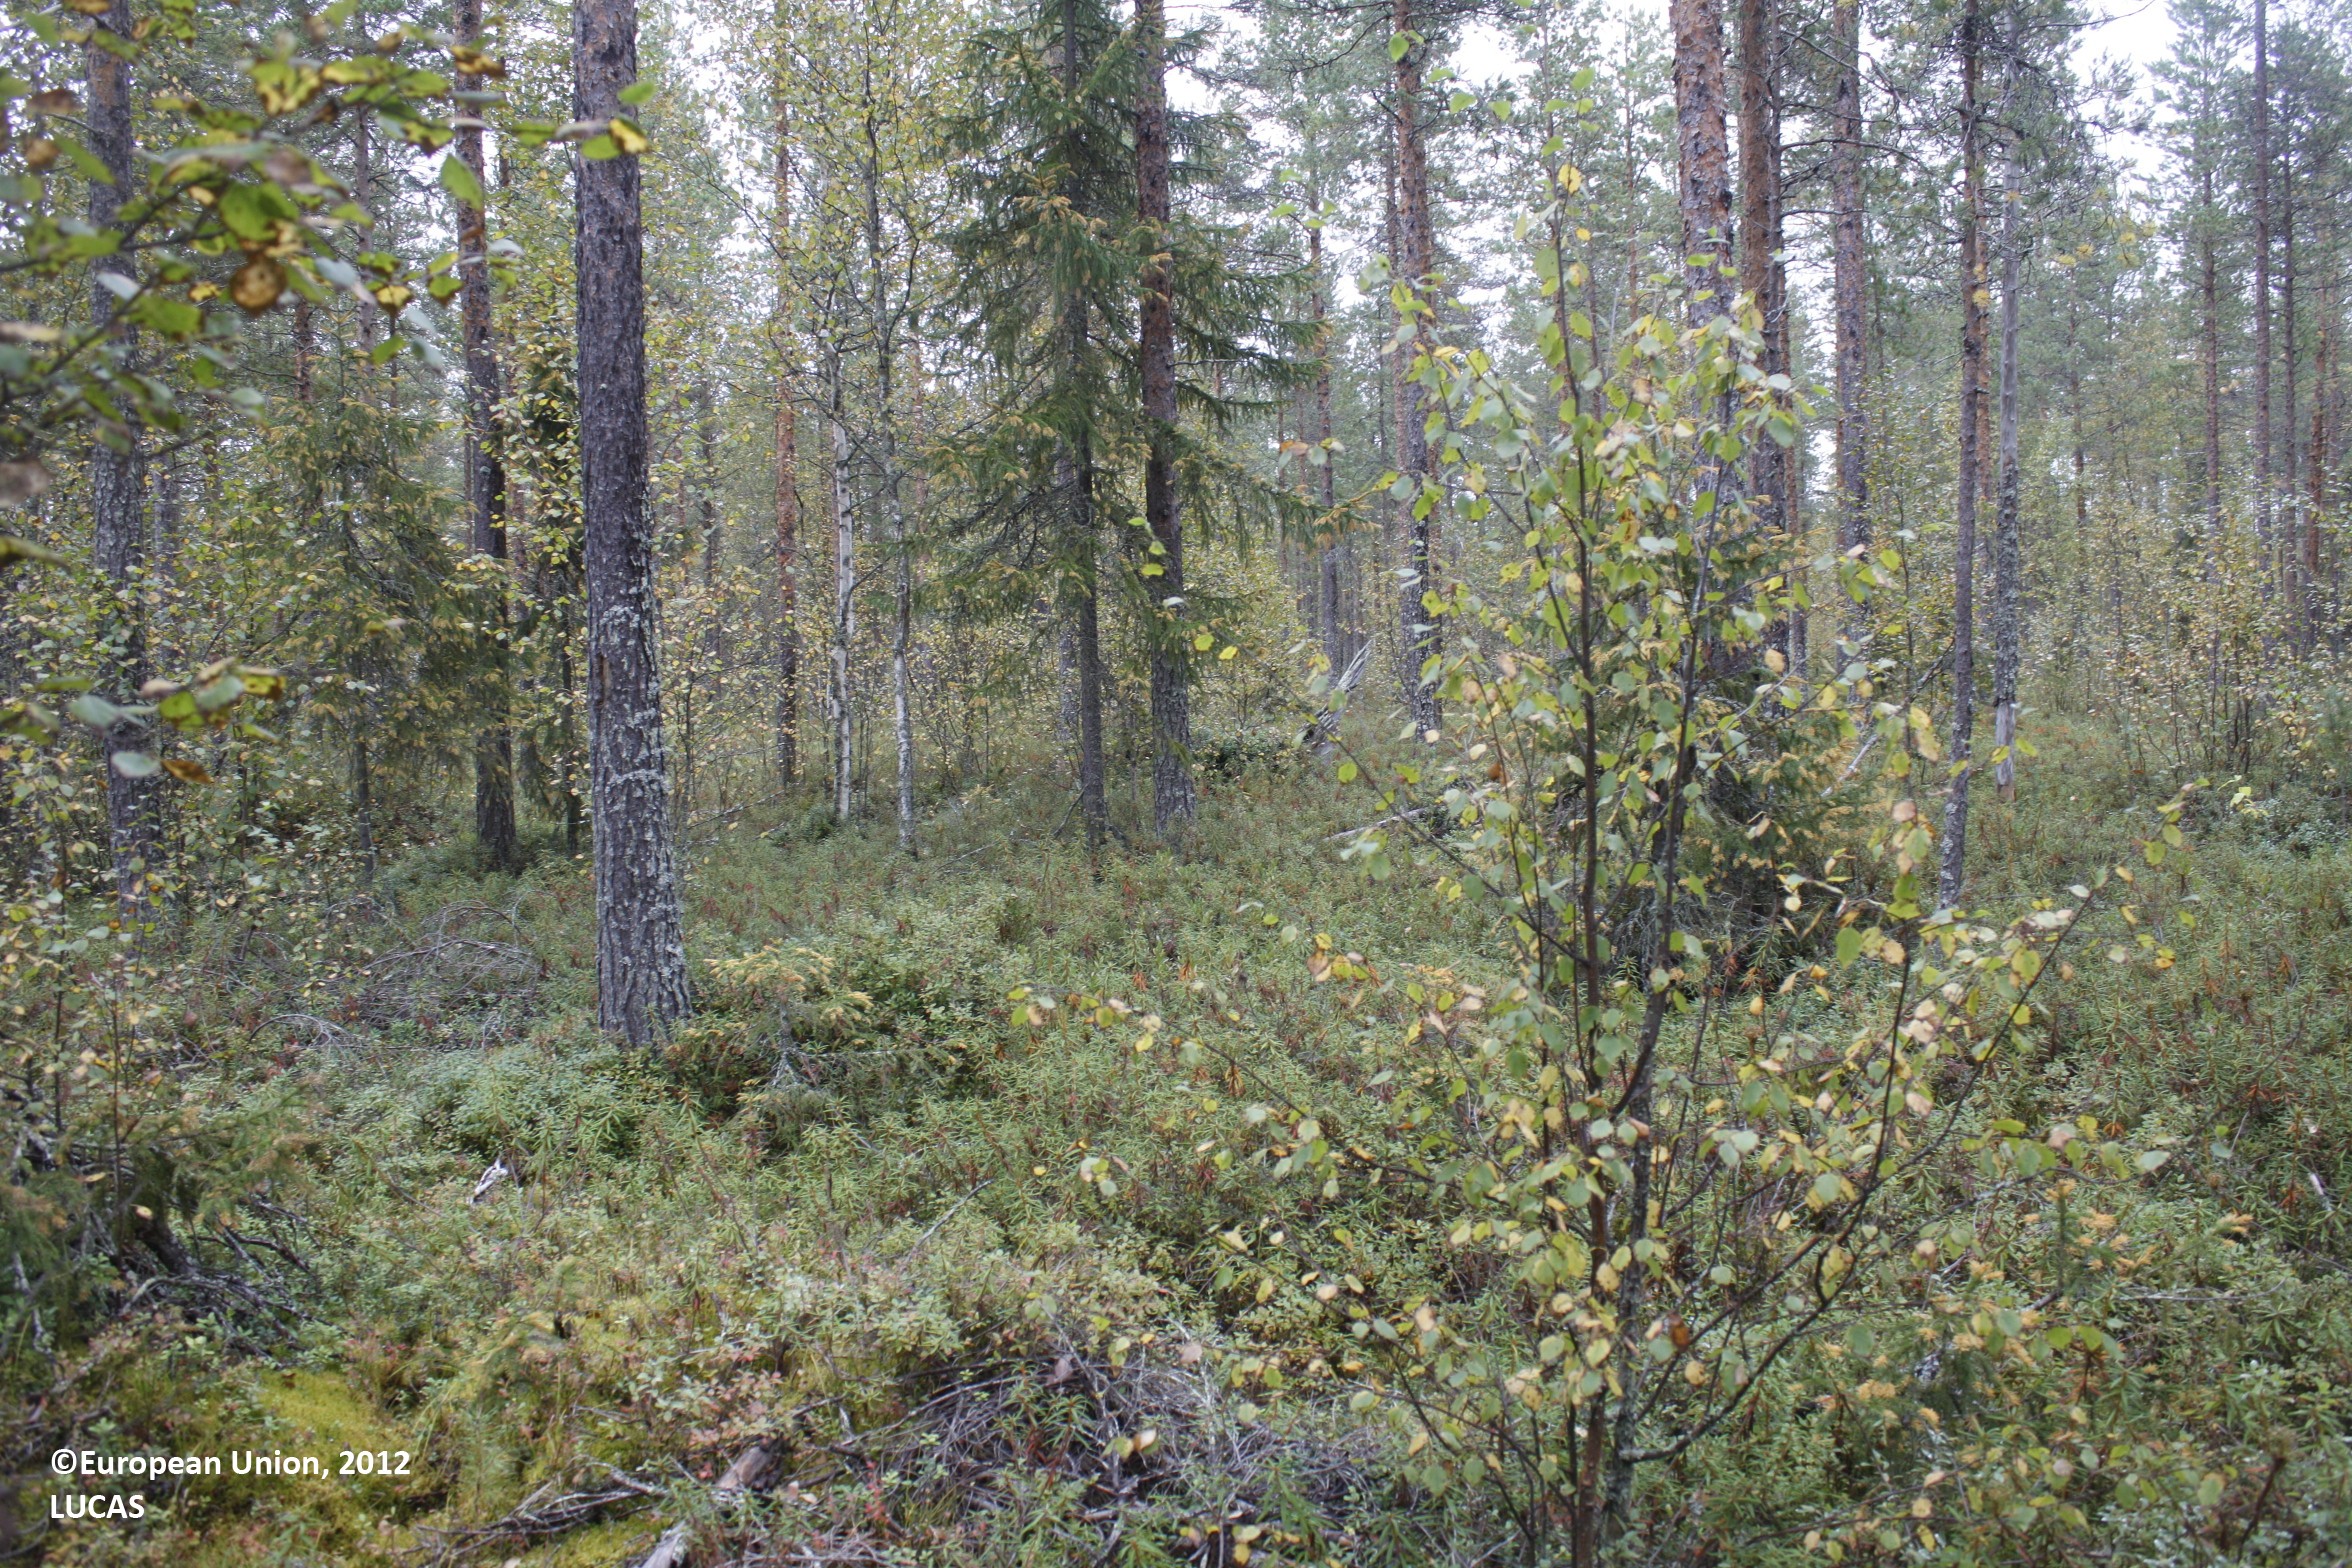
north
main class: Woodland
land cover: Pine dominated mixed woodland
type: boreal forest
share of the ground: 25 - 50 %
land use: Forestry
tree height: > 5 m
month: September
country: FI
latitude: 65.1269
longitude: 26.7984
